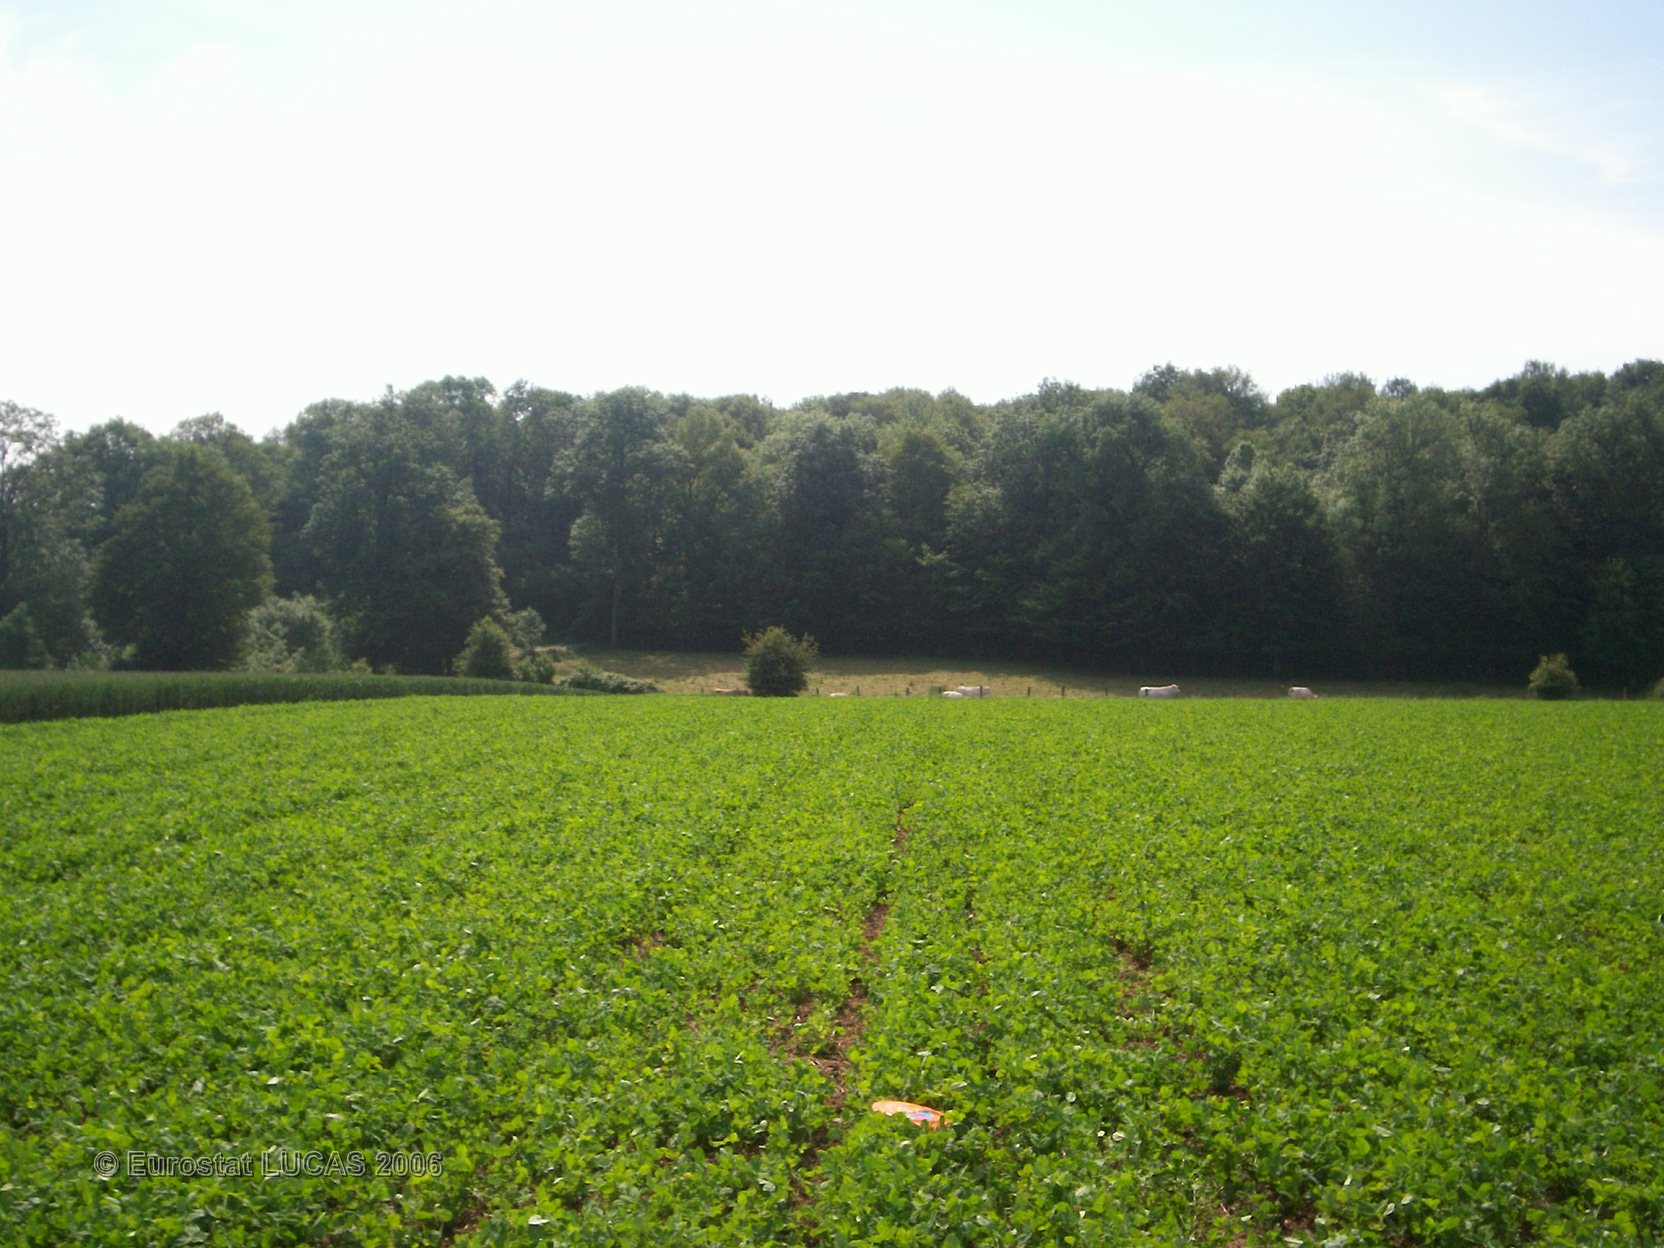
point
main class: Cropland
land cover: Clovers
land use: Agriculture (excluding fallow land and kitchen gardens)
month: June
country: FR
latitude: 49.5889
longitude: 2.6989
